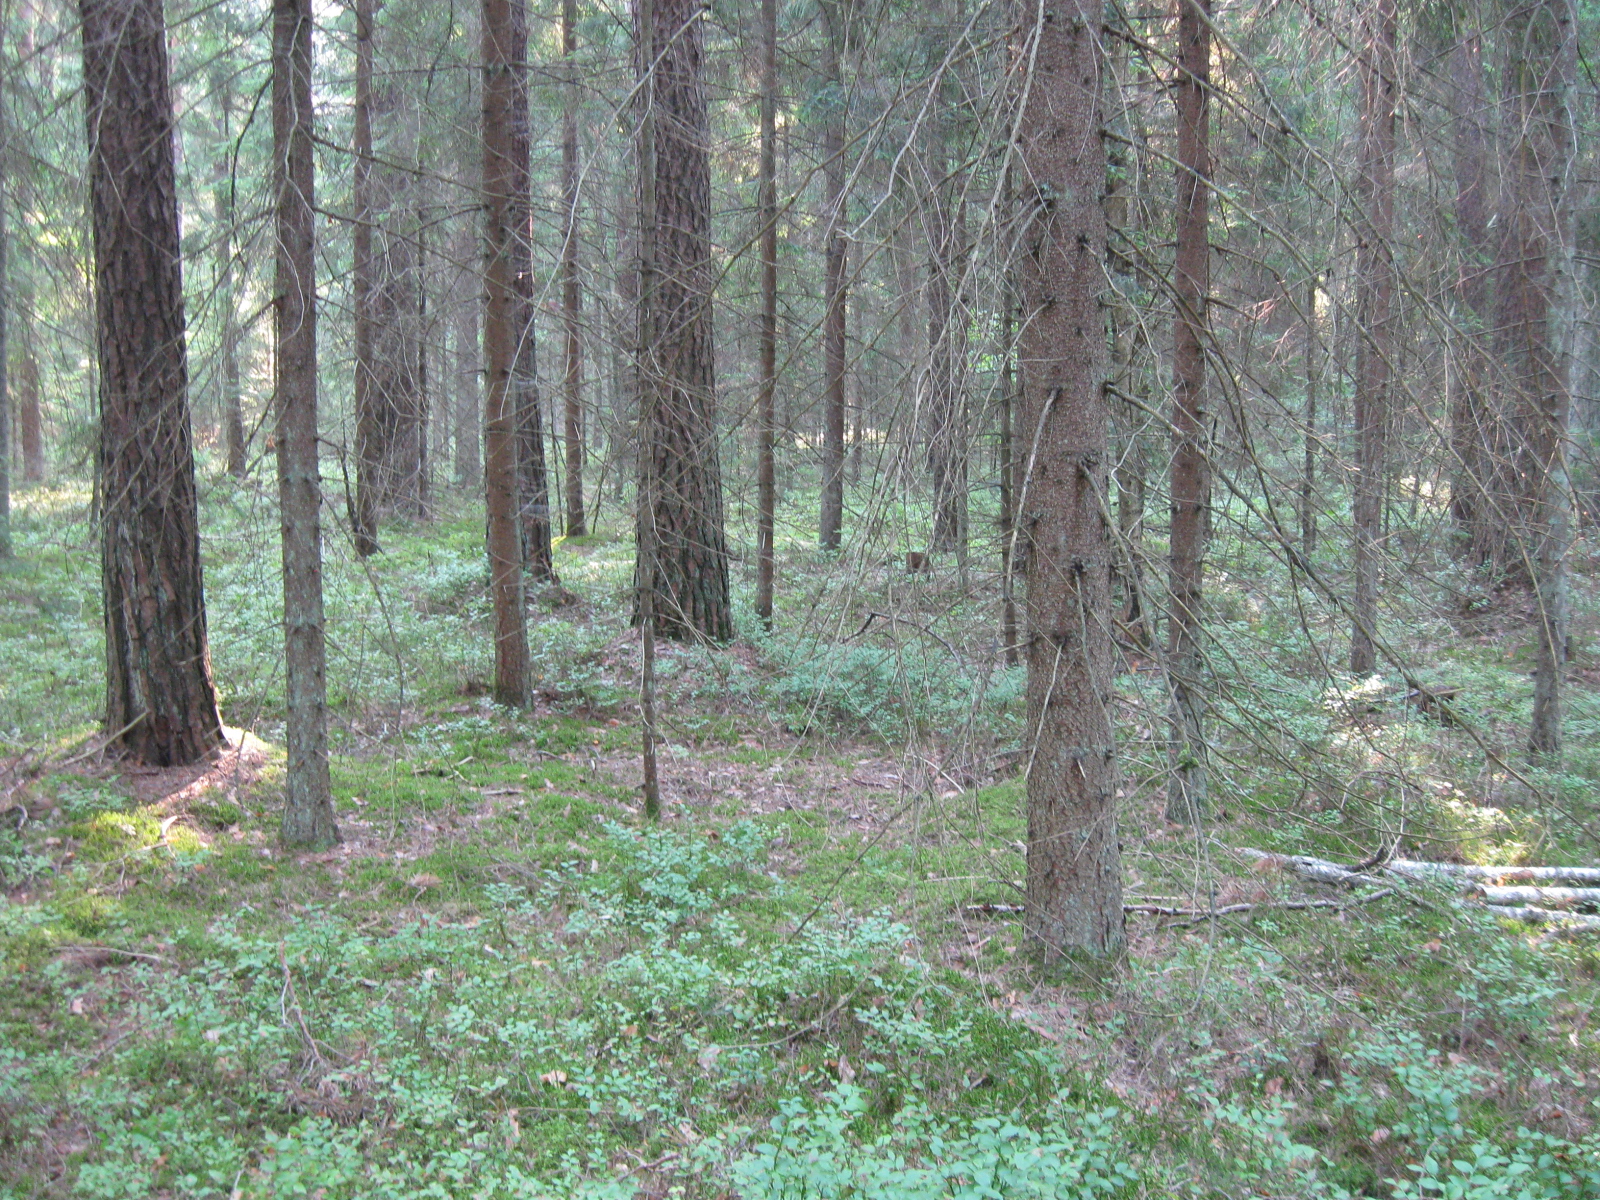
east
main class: Woodland
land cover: Other coniferous woodland
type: hemiboreal forest and nemoral coniferous forest and mixed broadleaved-coniferous forest
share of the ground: > 75 %
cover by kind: coniferous forest trees 85 %, shrubs 10 %, lichens and mosses 5 %
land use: Forestry
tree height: > 5 m
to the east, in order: Other coniferous woodland; Tracks; Other coniferous woodland; Other structural elements; Other coniferous woodland
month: August
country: LT
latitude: 54.8459
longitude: 23.3624
